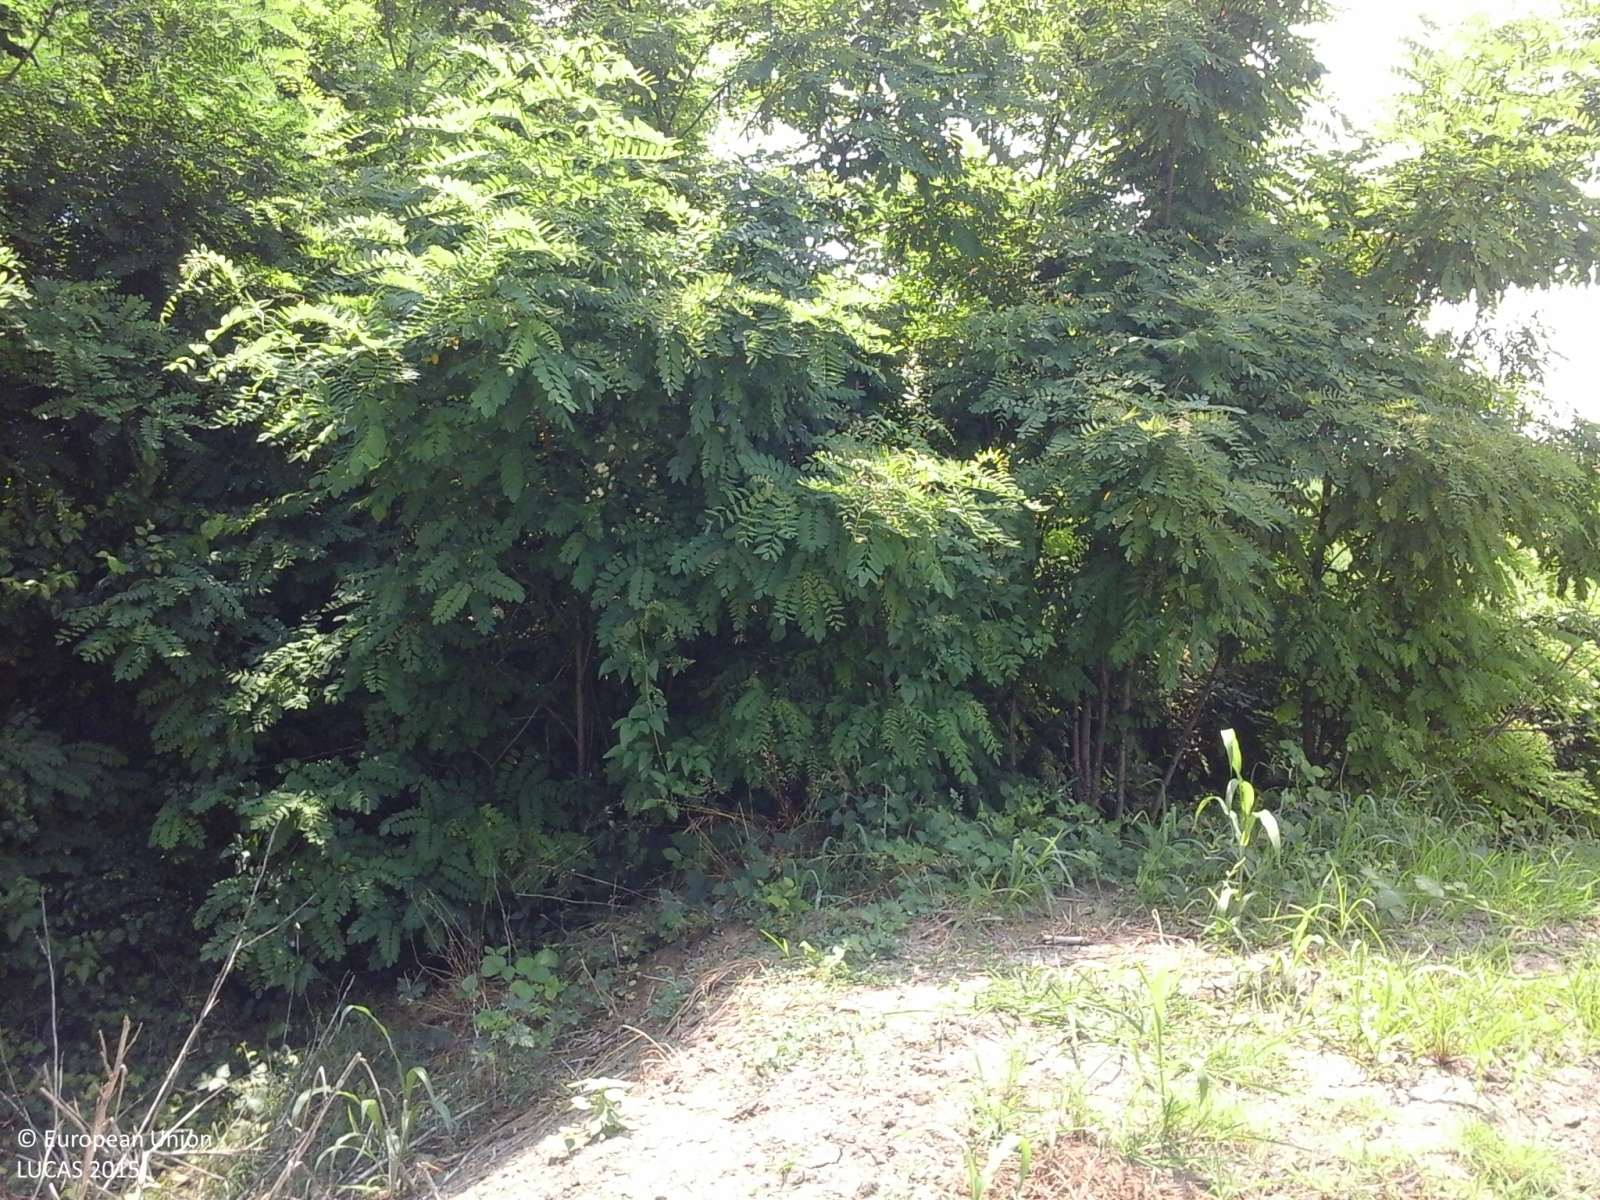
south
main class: Cropland
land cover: Maize
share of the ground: > 75 %
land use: Agriculture (excluding fallow land and kitchen gardens)
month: June
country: IT
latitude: 44.9816
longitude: 9.9114
